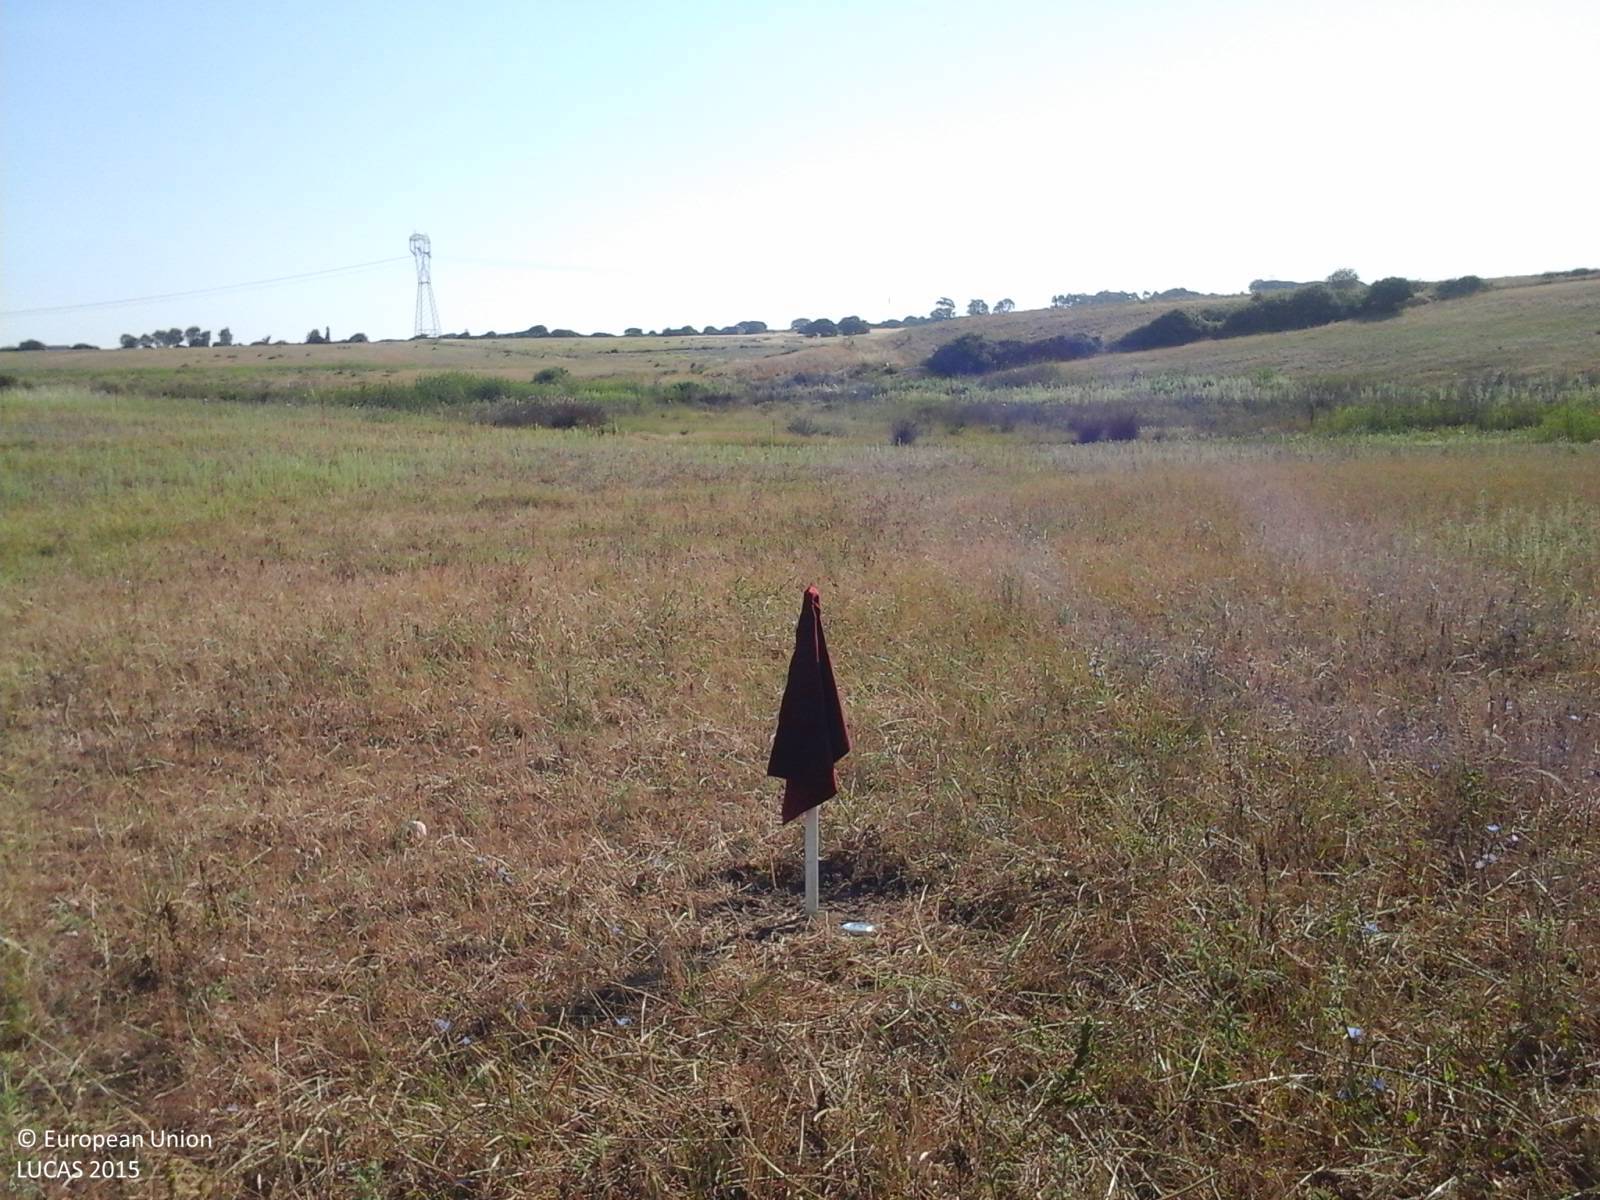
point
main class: Grassland
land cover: Grassland without tree/shrub cover
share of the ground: > 75 %
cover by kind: herbaceous plants 100 %
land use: Agriculture (excluding fallow land and kitchen gardens)
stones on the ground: < 10 %
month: June
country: IT
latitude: 40.7070
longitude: 8.4098
